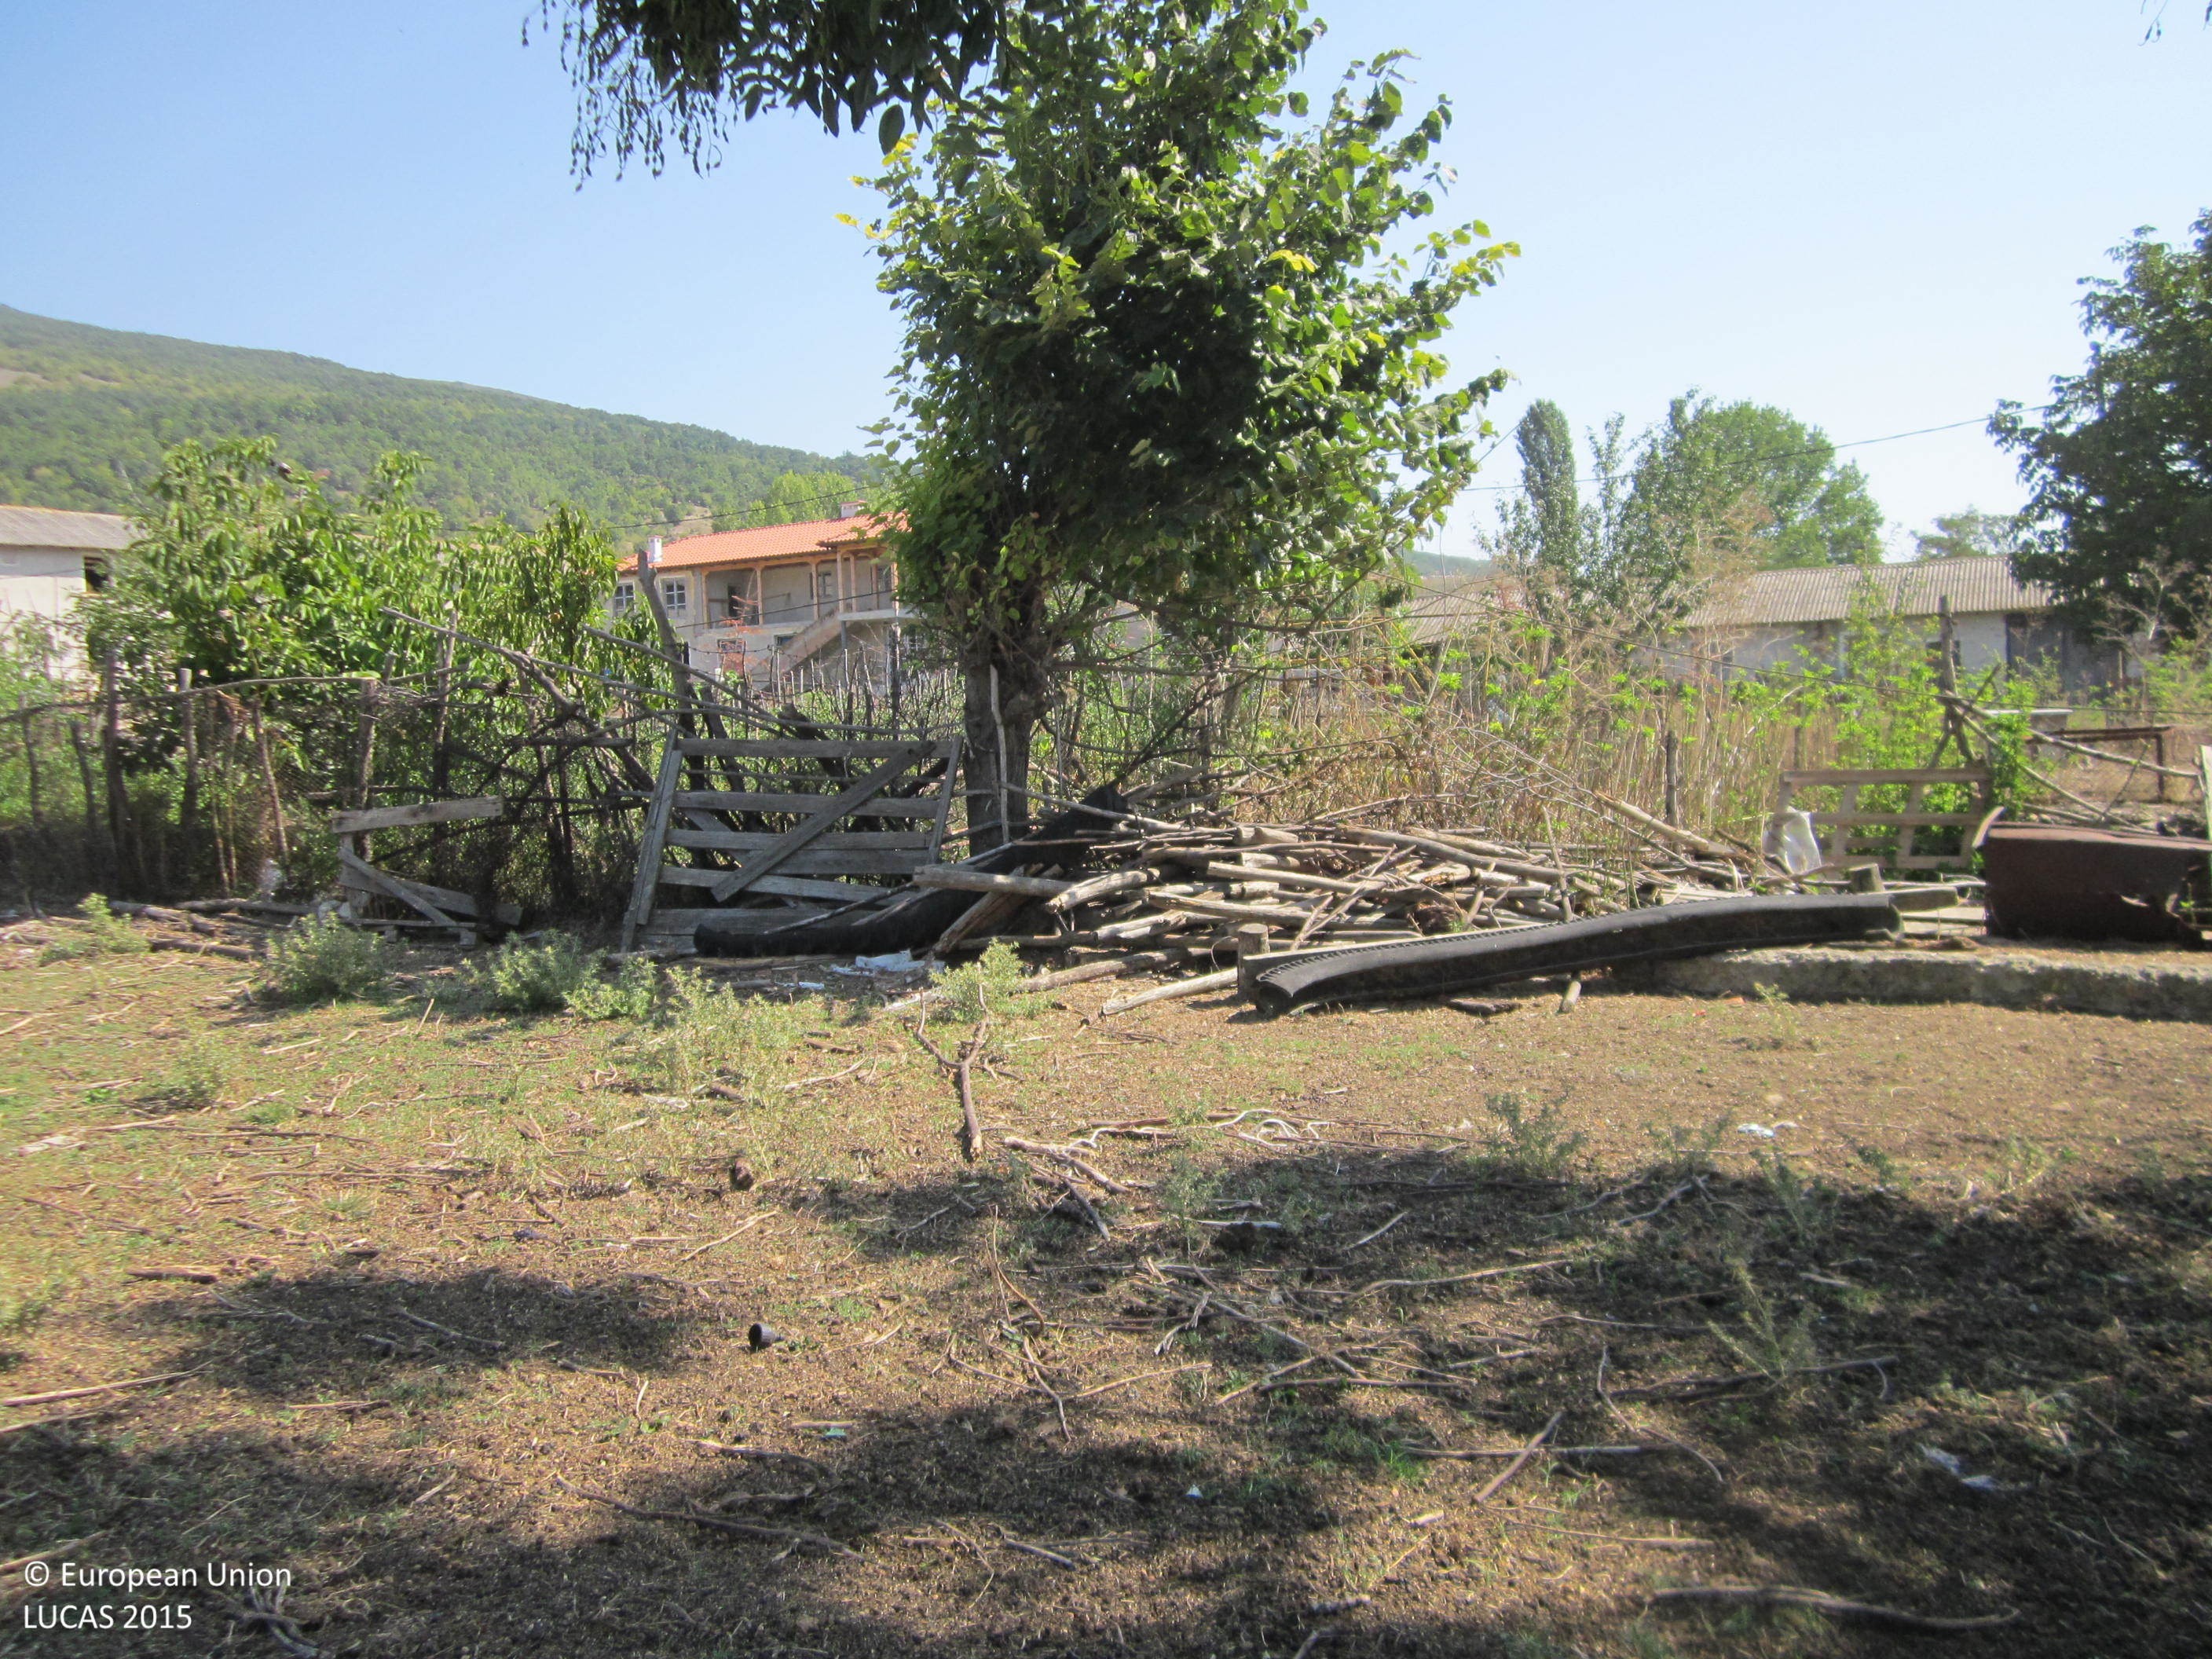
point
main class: Grassland
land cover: Grassland with sparse tree/shrub cover
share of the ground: > 75 %
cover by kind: herbaceous plants 80 %, unconsolidated bare surface 10 %, broadleaved forest trees 5 %, shrubs 5 %
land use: Residential
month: September
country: BG
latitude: 42.8853
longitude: 26.9688
